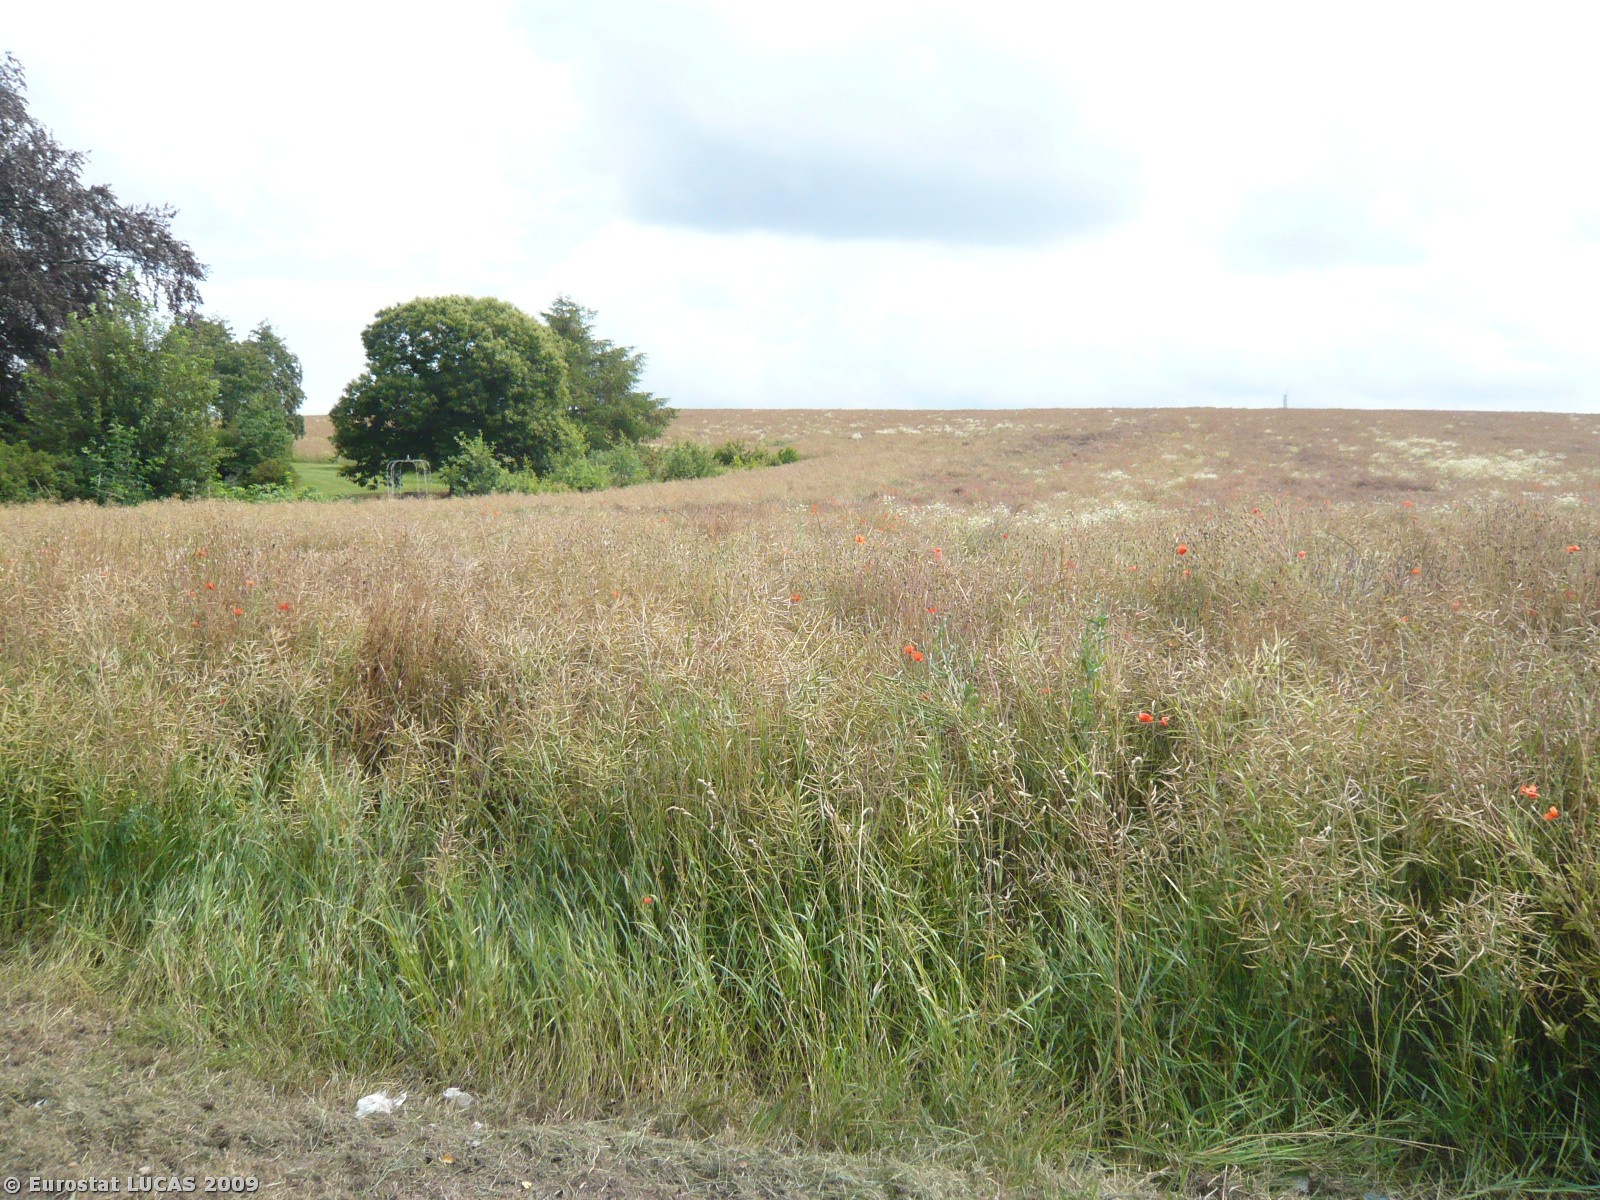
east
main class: Grassland
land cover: Grassland without tree/shrub cover
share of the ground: > 75 %
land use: Residential
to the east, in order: Grassland without tree/shrub cover; Broadleaved woodland; Rape and turnip rape
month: July
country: DK
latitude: 55.8291
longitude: 12.0894
